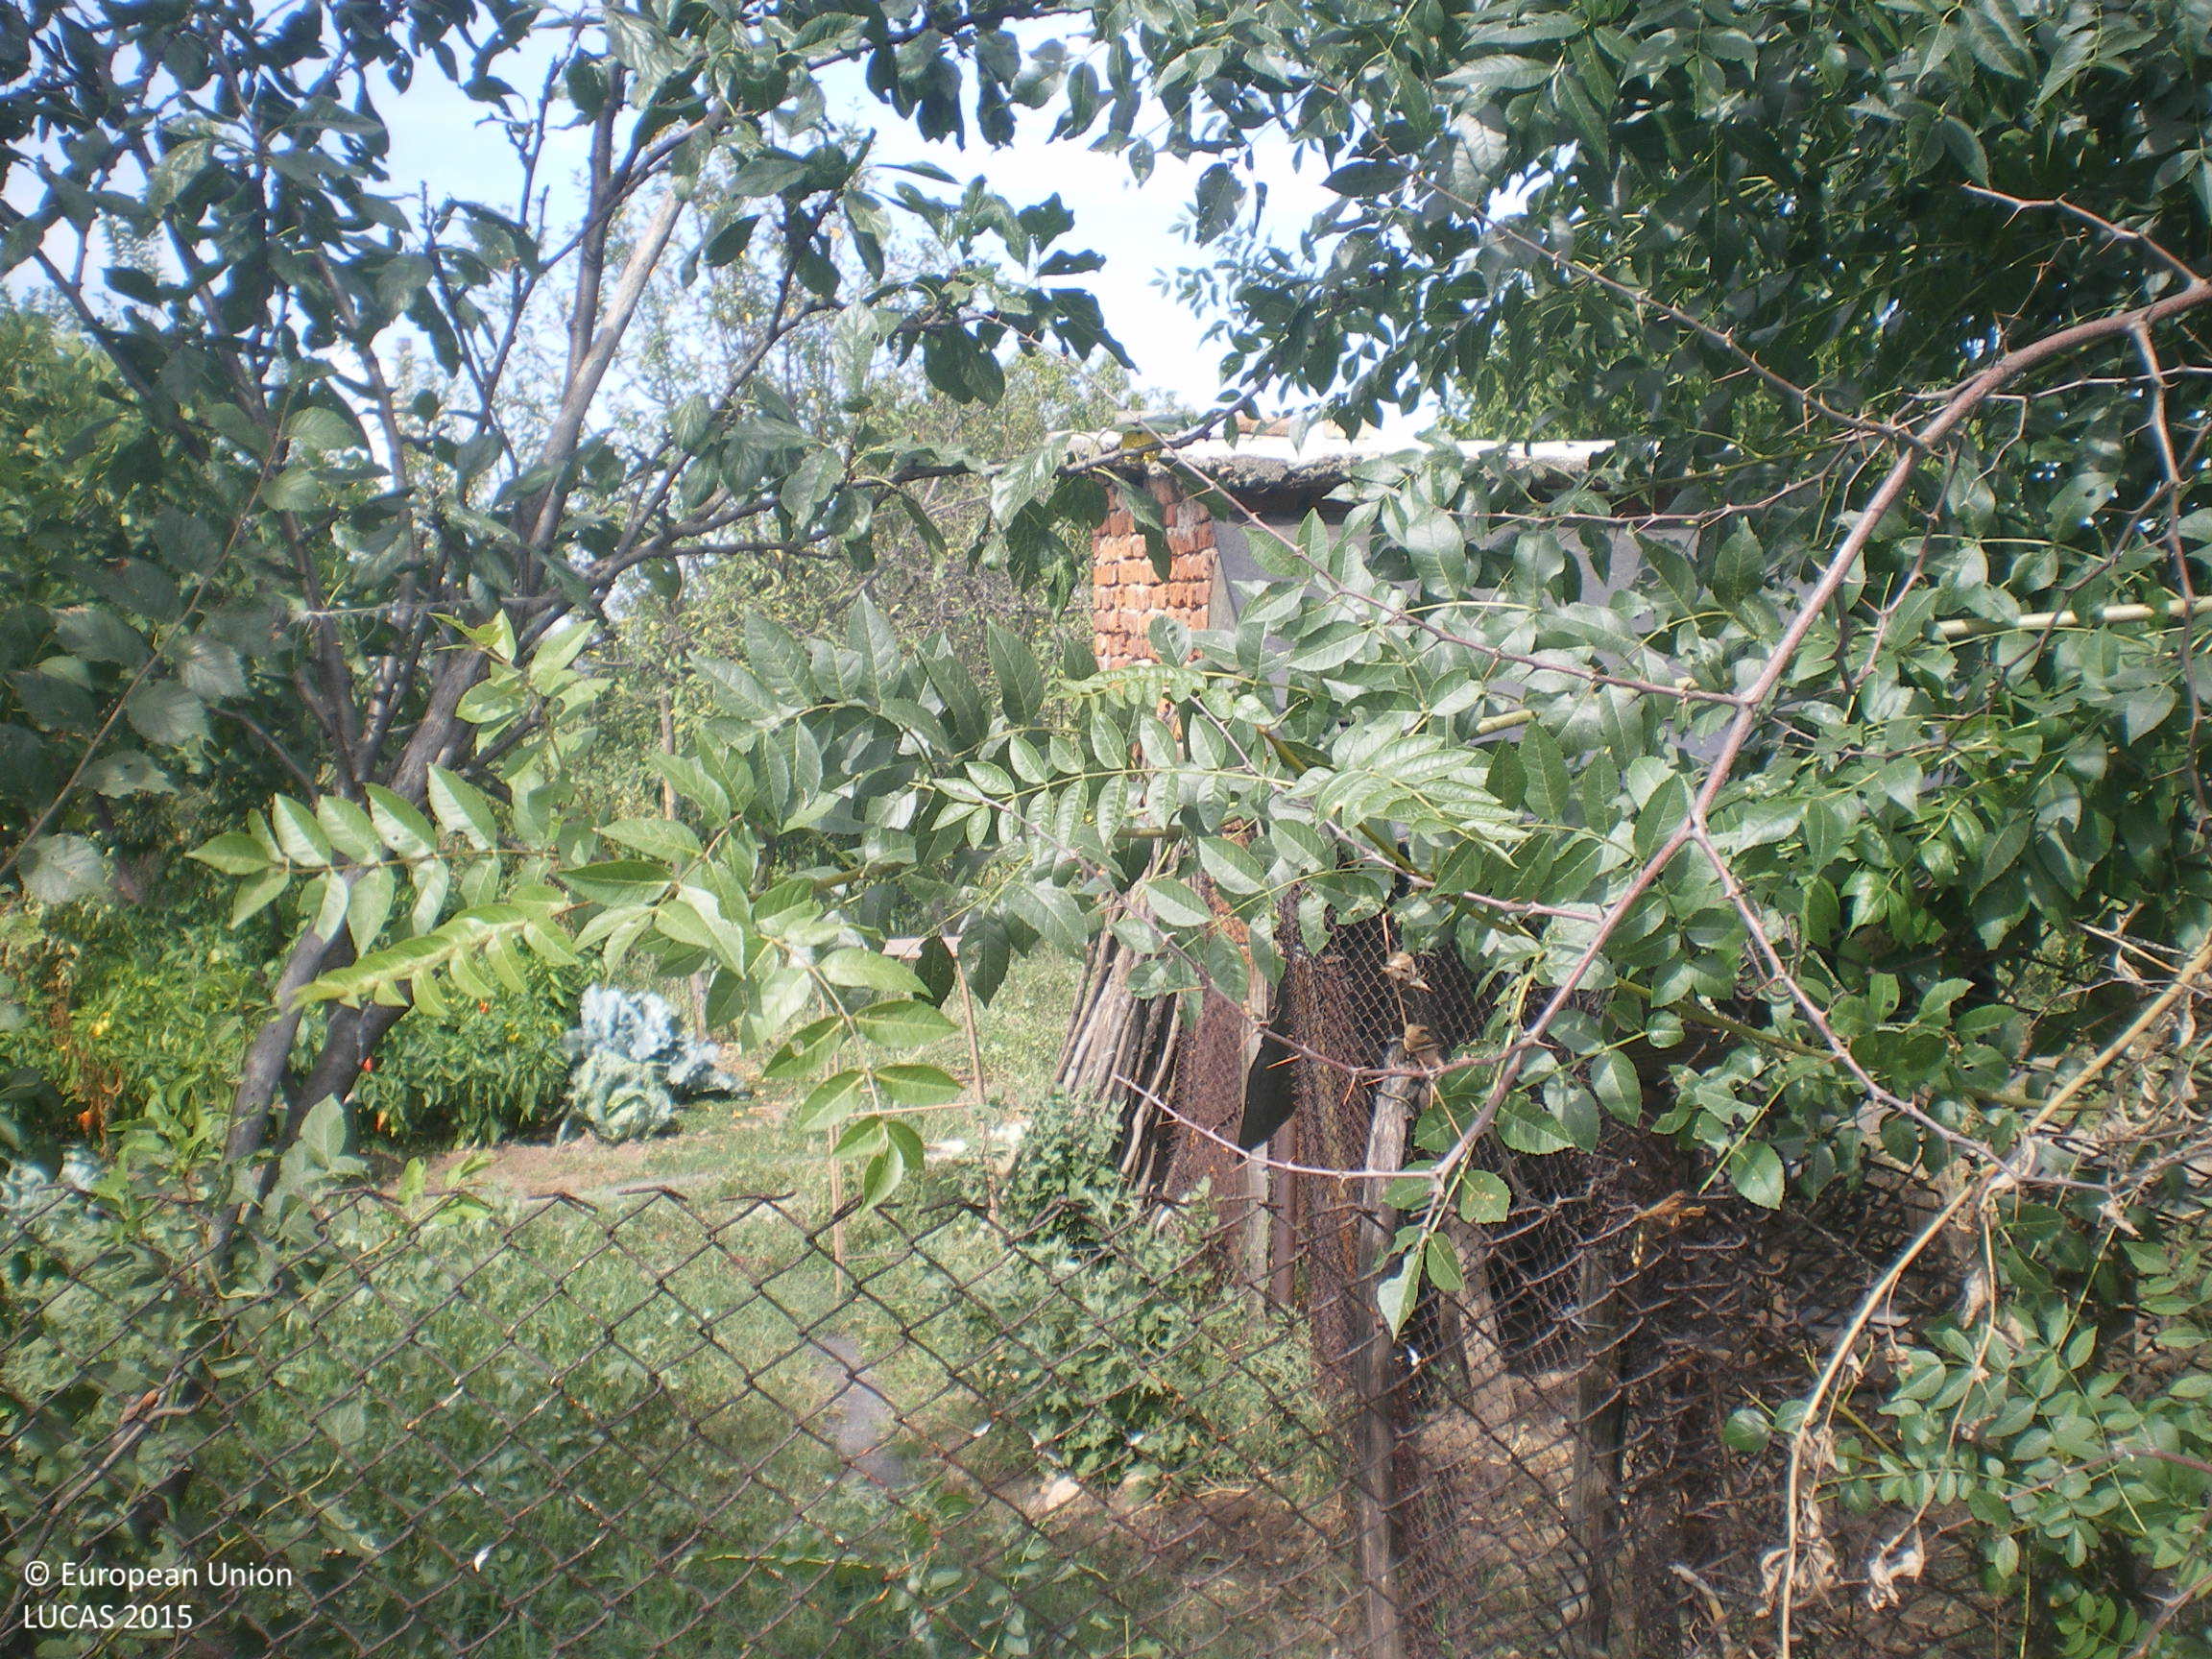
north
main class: Cropland
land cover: Other fresh vegetables
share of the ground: 50 - 75 %
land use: Kitchen garden
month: September
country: BG
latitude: 42.1247
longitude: 26.0072
